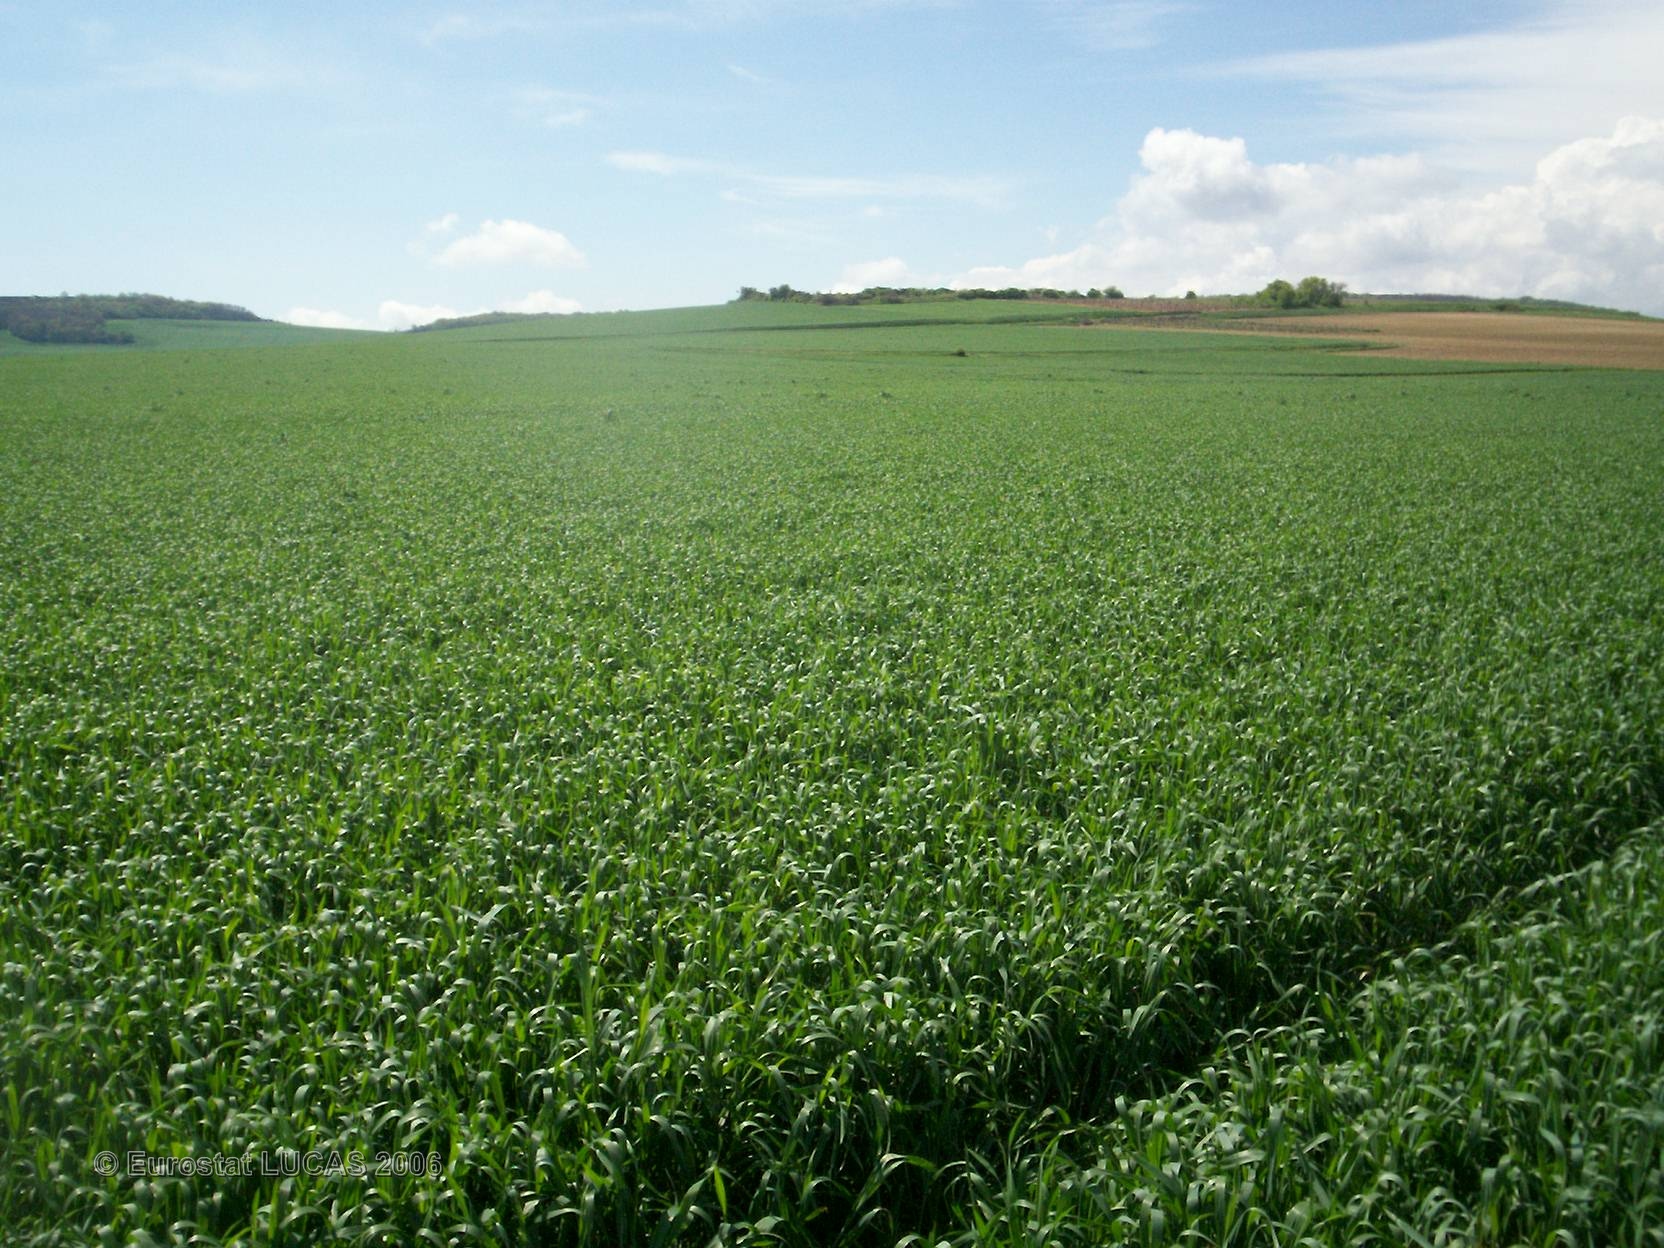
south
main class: Cropland
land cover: Common wheat
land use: Agriculture (excluding fallow land and kitchen gardens)
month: May
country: FR
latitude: 45.5921
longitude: 3.1940
